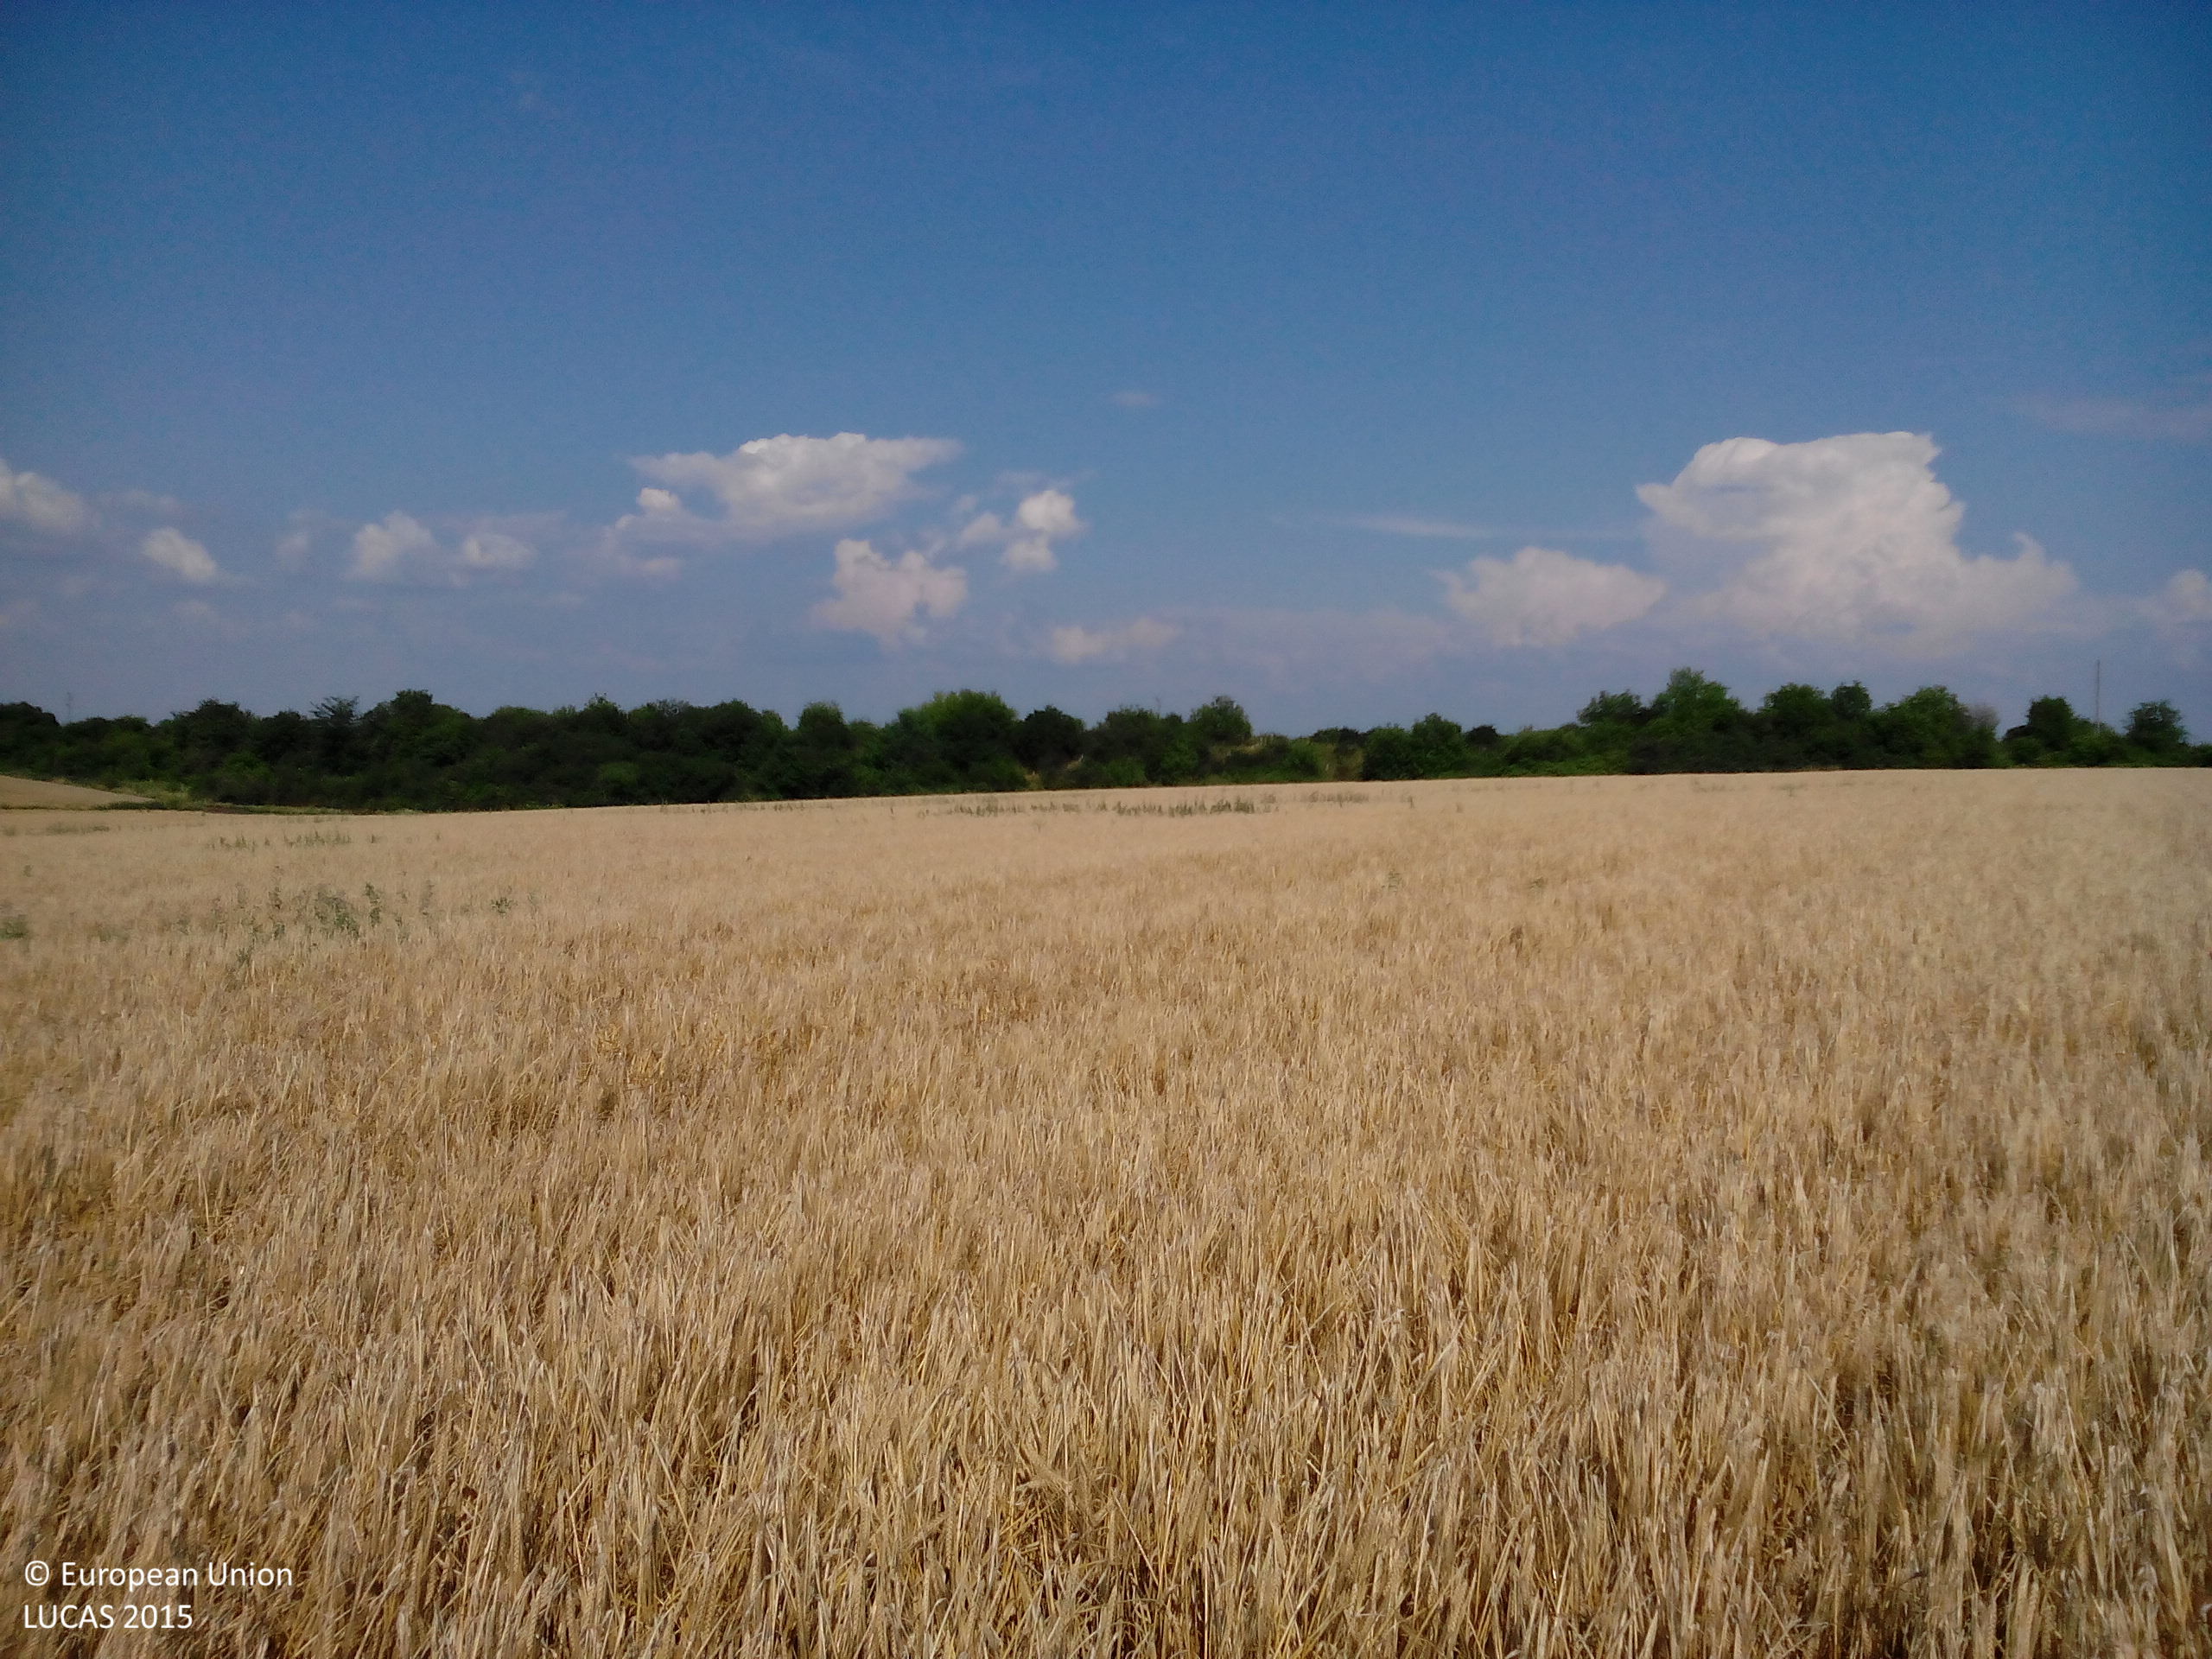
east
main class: Cropland
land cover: Barley
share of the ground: > 75 %
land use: Agriculture (excluding fallow land and kitchen gardens)
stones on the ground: < 10 %
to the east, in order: Barley; Grass margins; Tracks; Broadleaved woodland; Inland fresh running water; Electric lines; Shrubland with sparse tree cover; Tracks
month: July
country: BG
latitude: 43.4382
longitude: 24.3529
